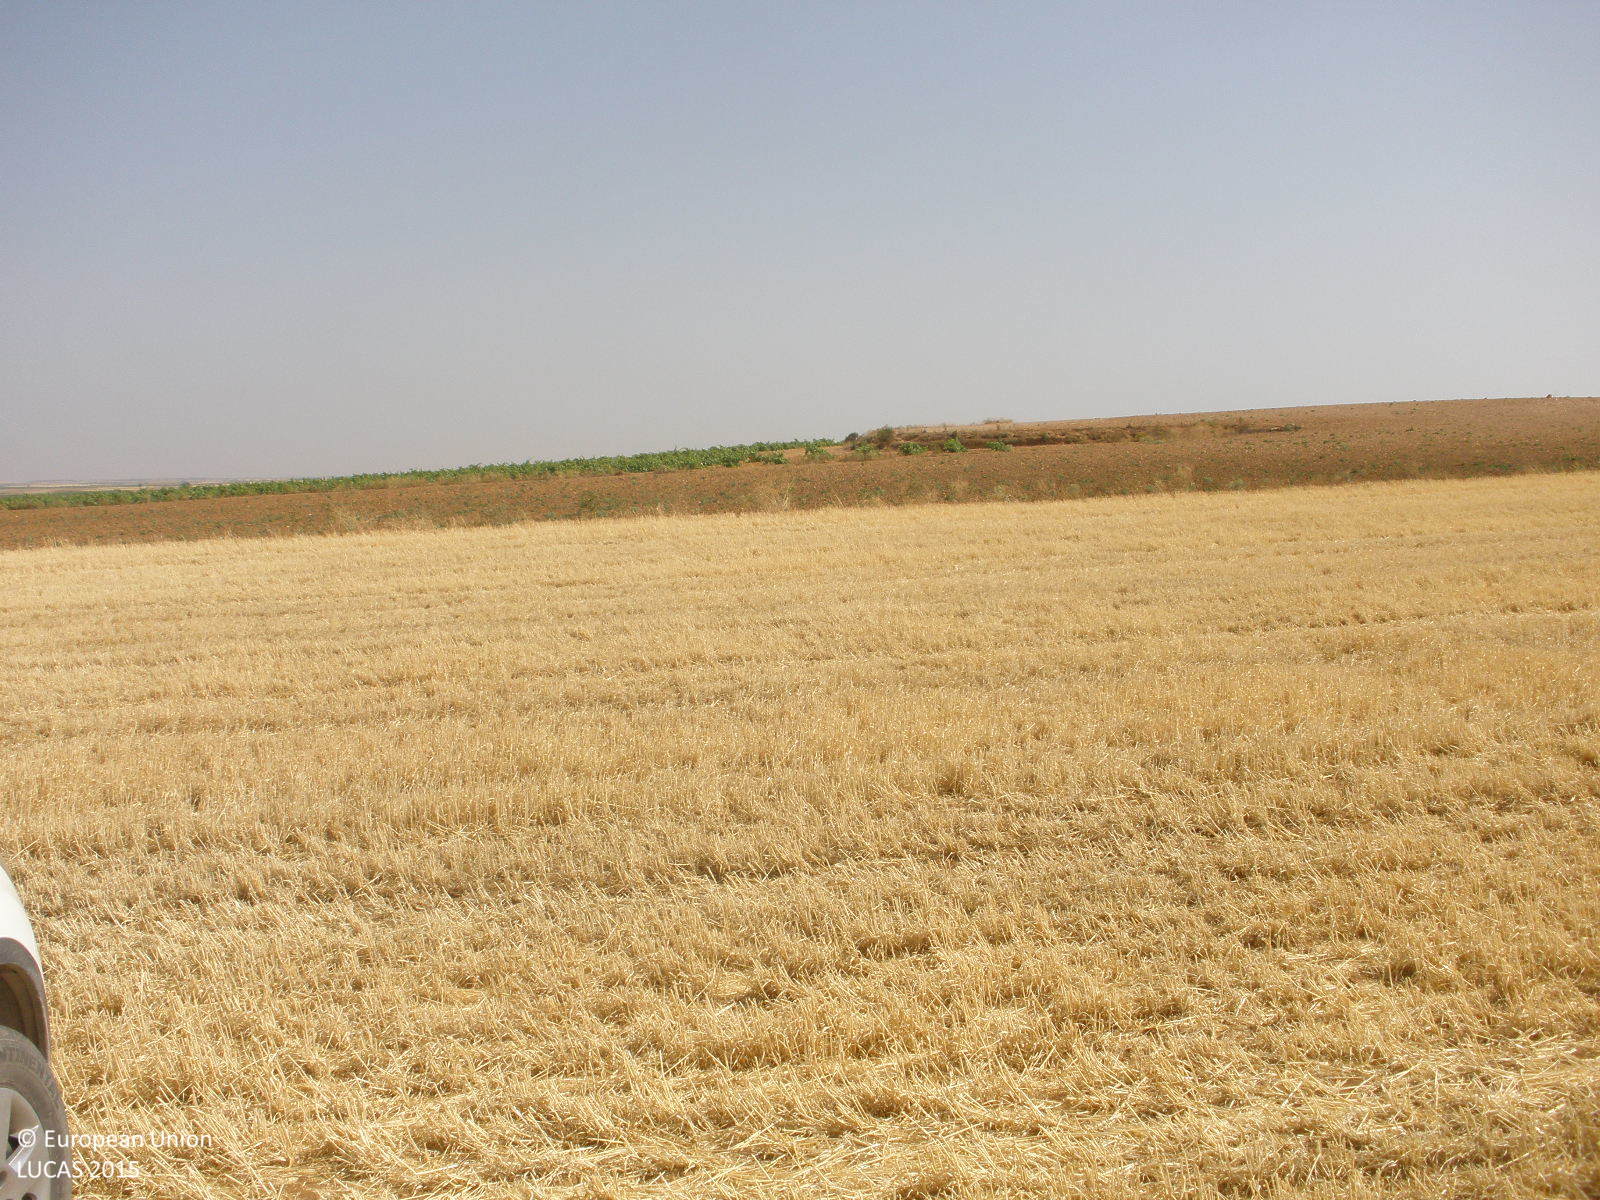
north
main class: Cropland
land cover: Barley
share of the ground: < 10 %
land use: Agriculture (excluding fallow land and kitchen gardens)
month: July
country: ES
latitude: 39.7503
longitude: -3.1046
